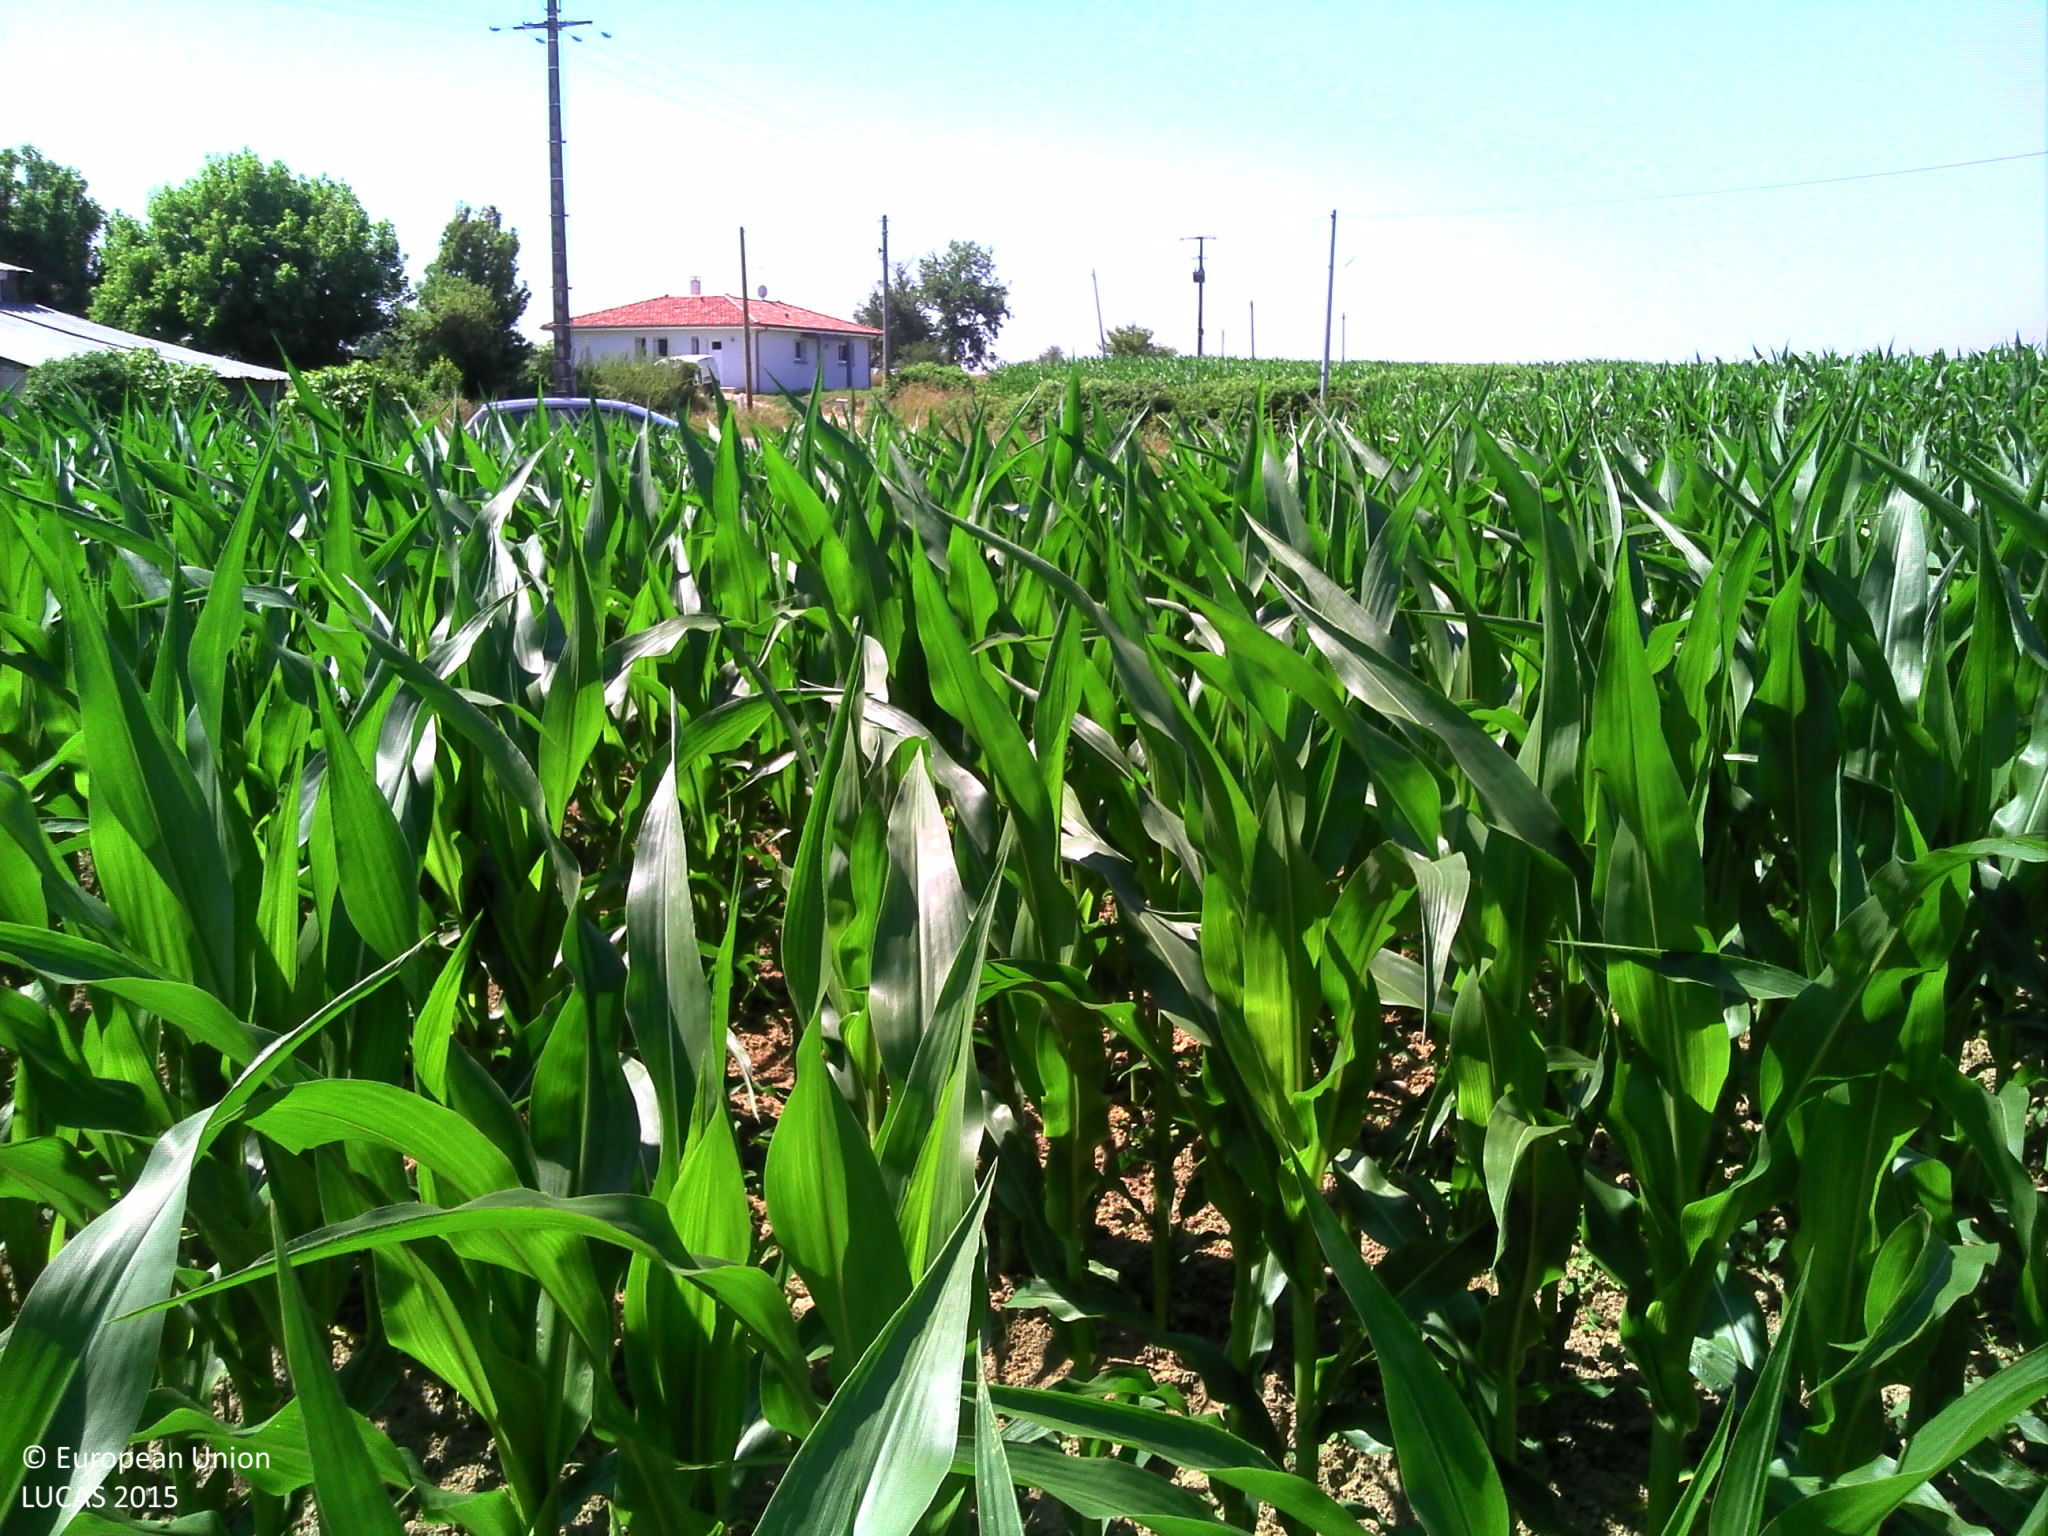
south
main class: Cropland
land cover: Maize
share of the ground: > 75 %
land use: Agriculture (excluding fallow land and kitchen gardens)
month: June
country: FR
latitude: 43.6108
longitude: -0.5545
